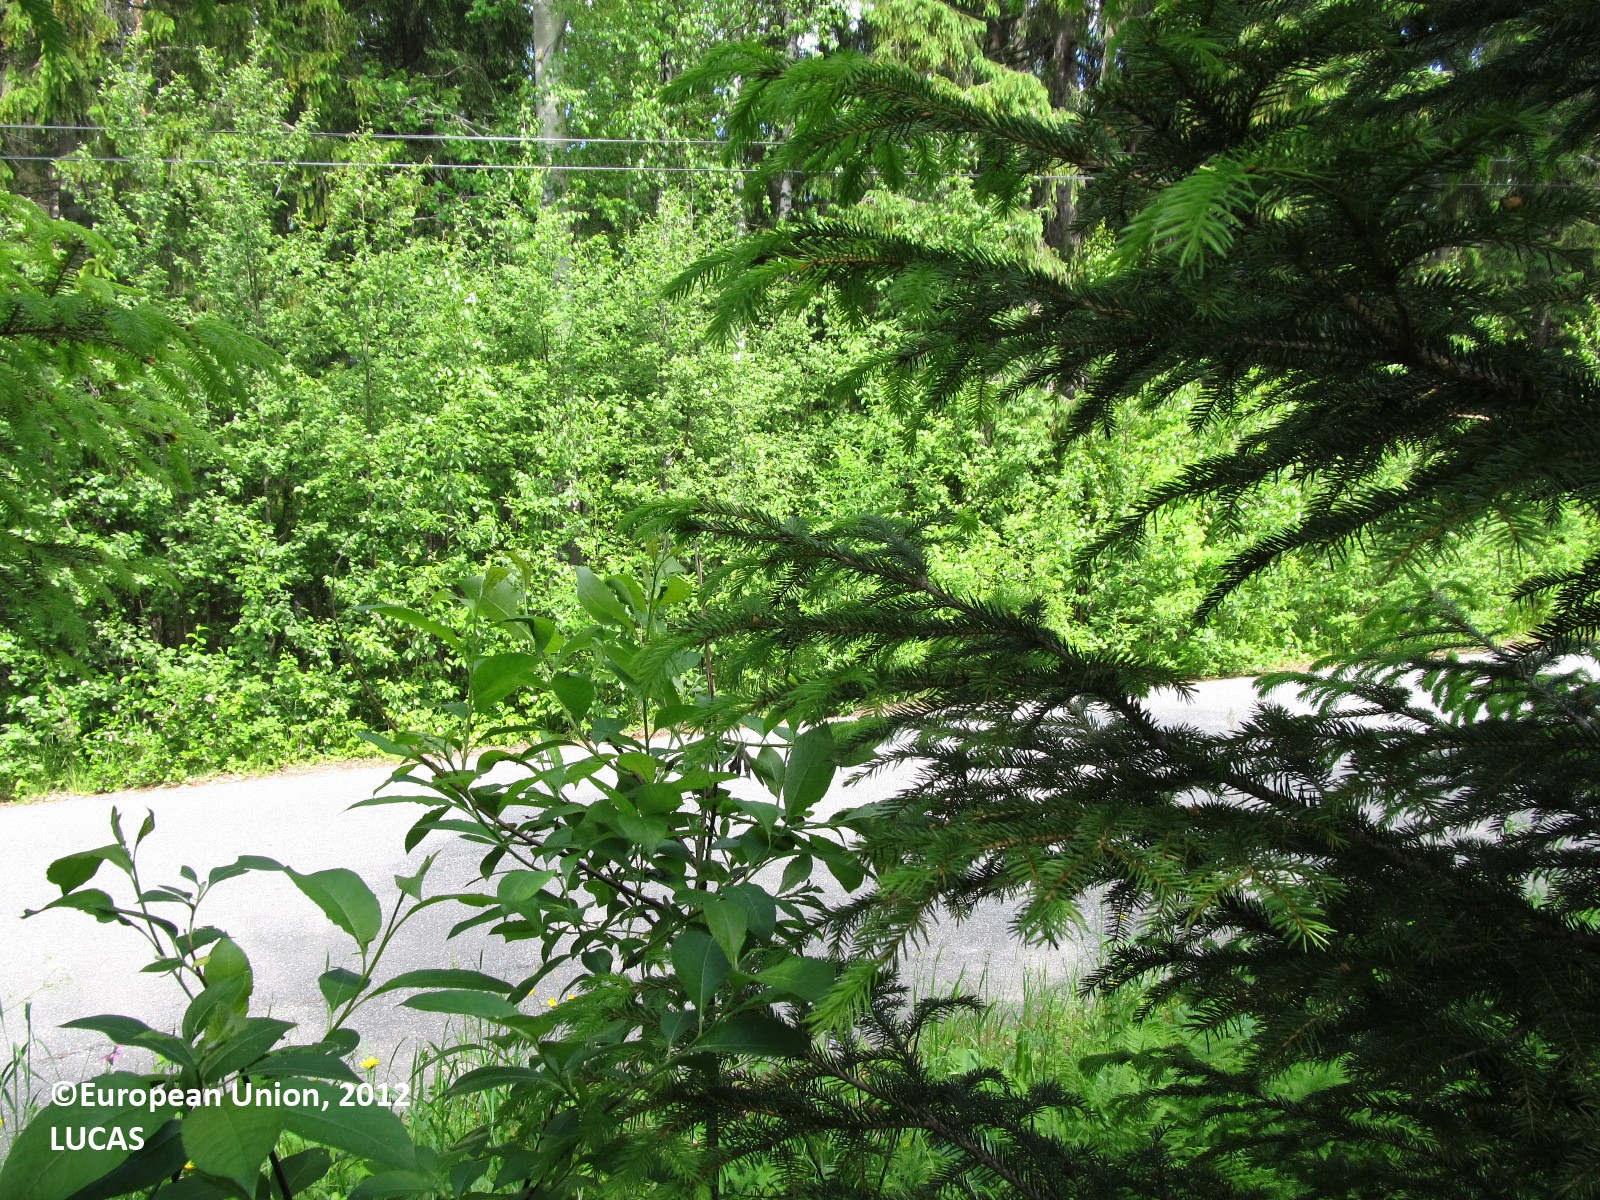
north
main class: Woodland
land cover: Broadleaved woodland
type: boreal forest
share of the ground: 50 - 75 %
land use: Forestry
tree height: > 5 m
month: June
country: FI
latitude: 62.8760
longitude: 27.4834
